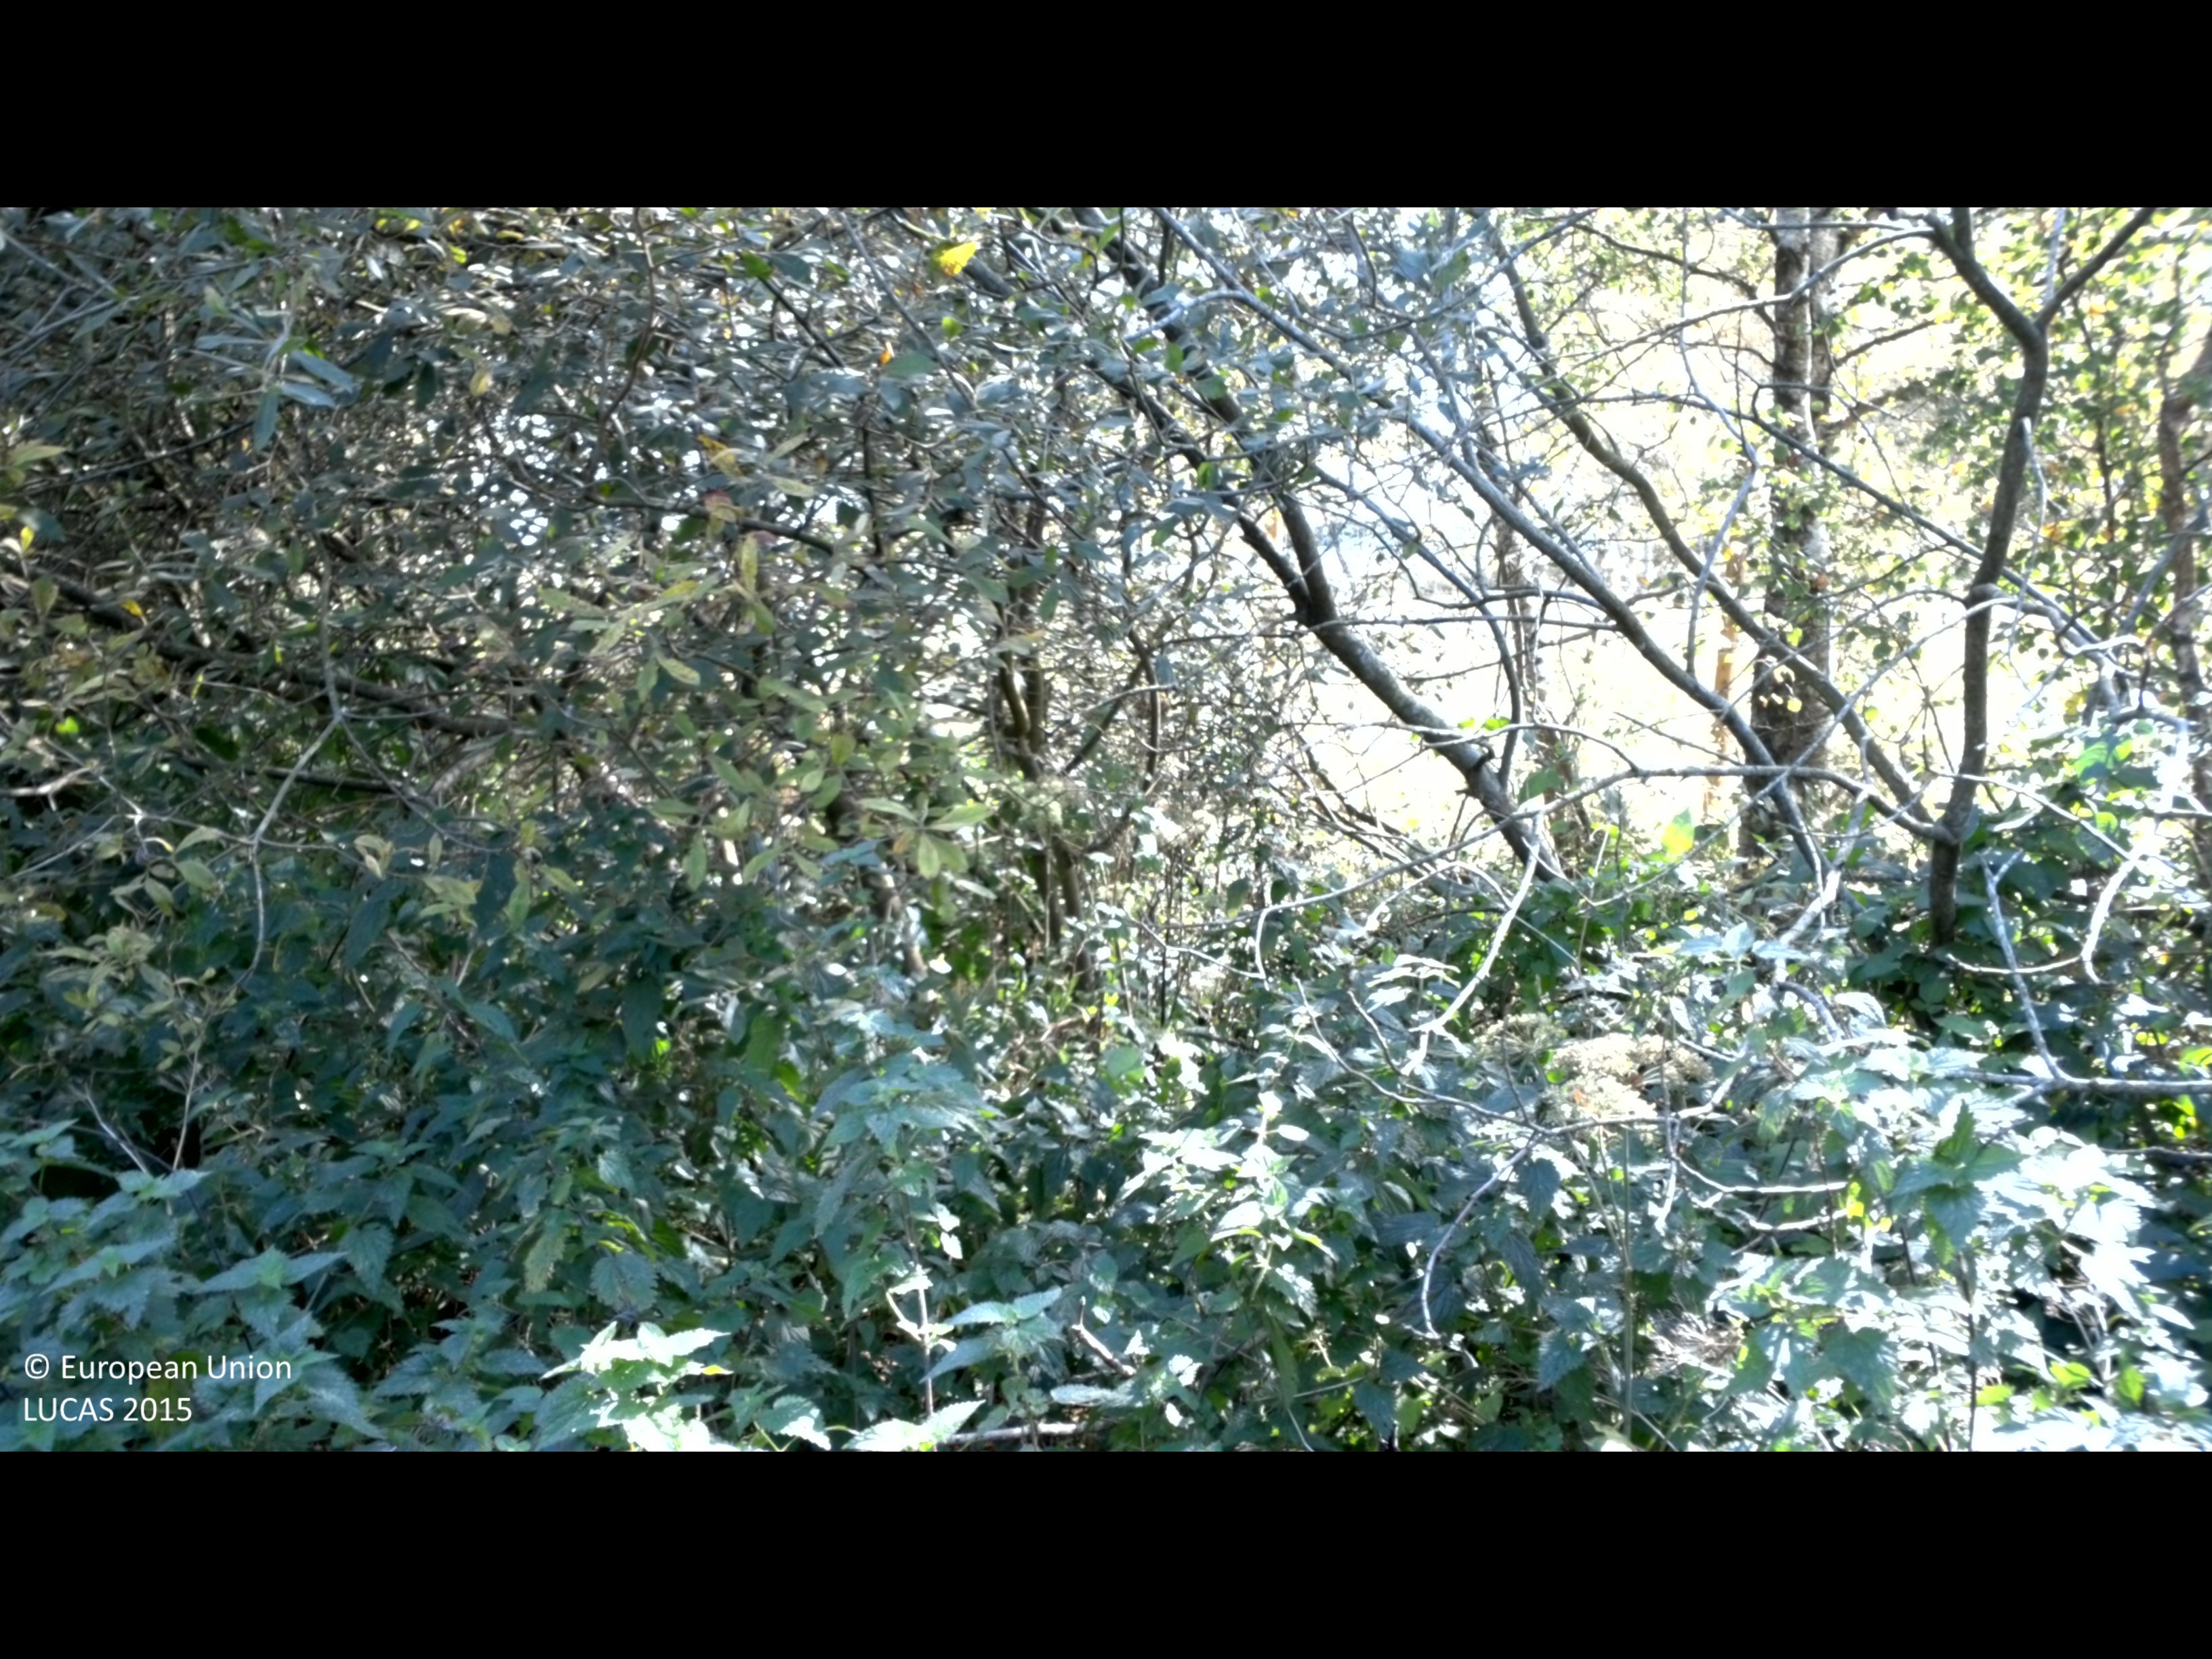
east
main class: Woodland
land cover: Broadleaved woodland
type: hemiboreal forest and nemoral coniferous forest and mixed broadleaved-coniferous forest
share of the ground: > 75 %
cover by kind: broadleaved forest trees 75 %, herbaceous plants 25 %
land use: Forestry
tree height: < 5 m
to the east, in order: Broadleaved woodland; Ditches and canals; Fences; Broadleaved woodland; Grassland without tree/shrub cover; Fences; Grassland without tree/shrub cover
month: September
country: SE
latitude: 56.0242
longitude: 14.3462
